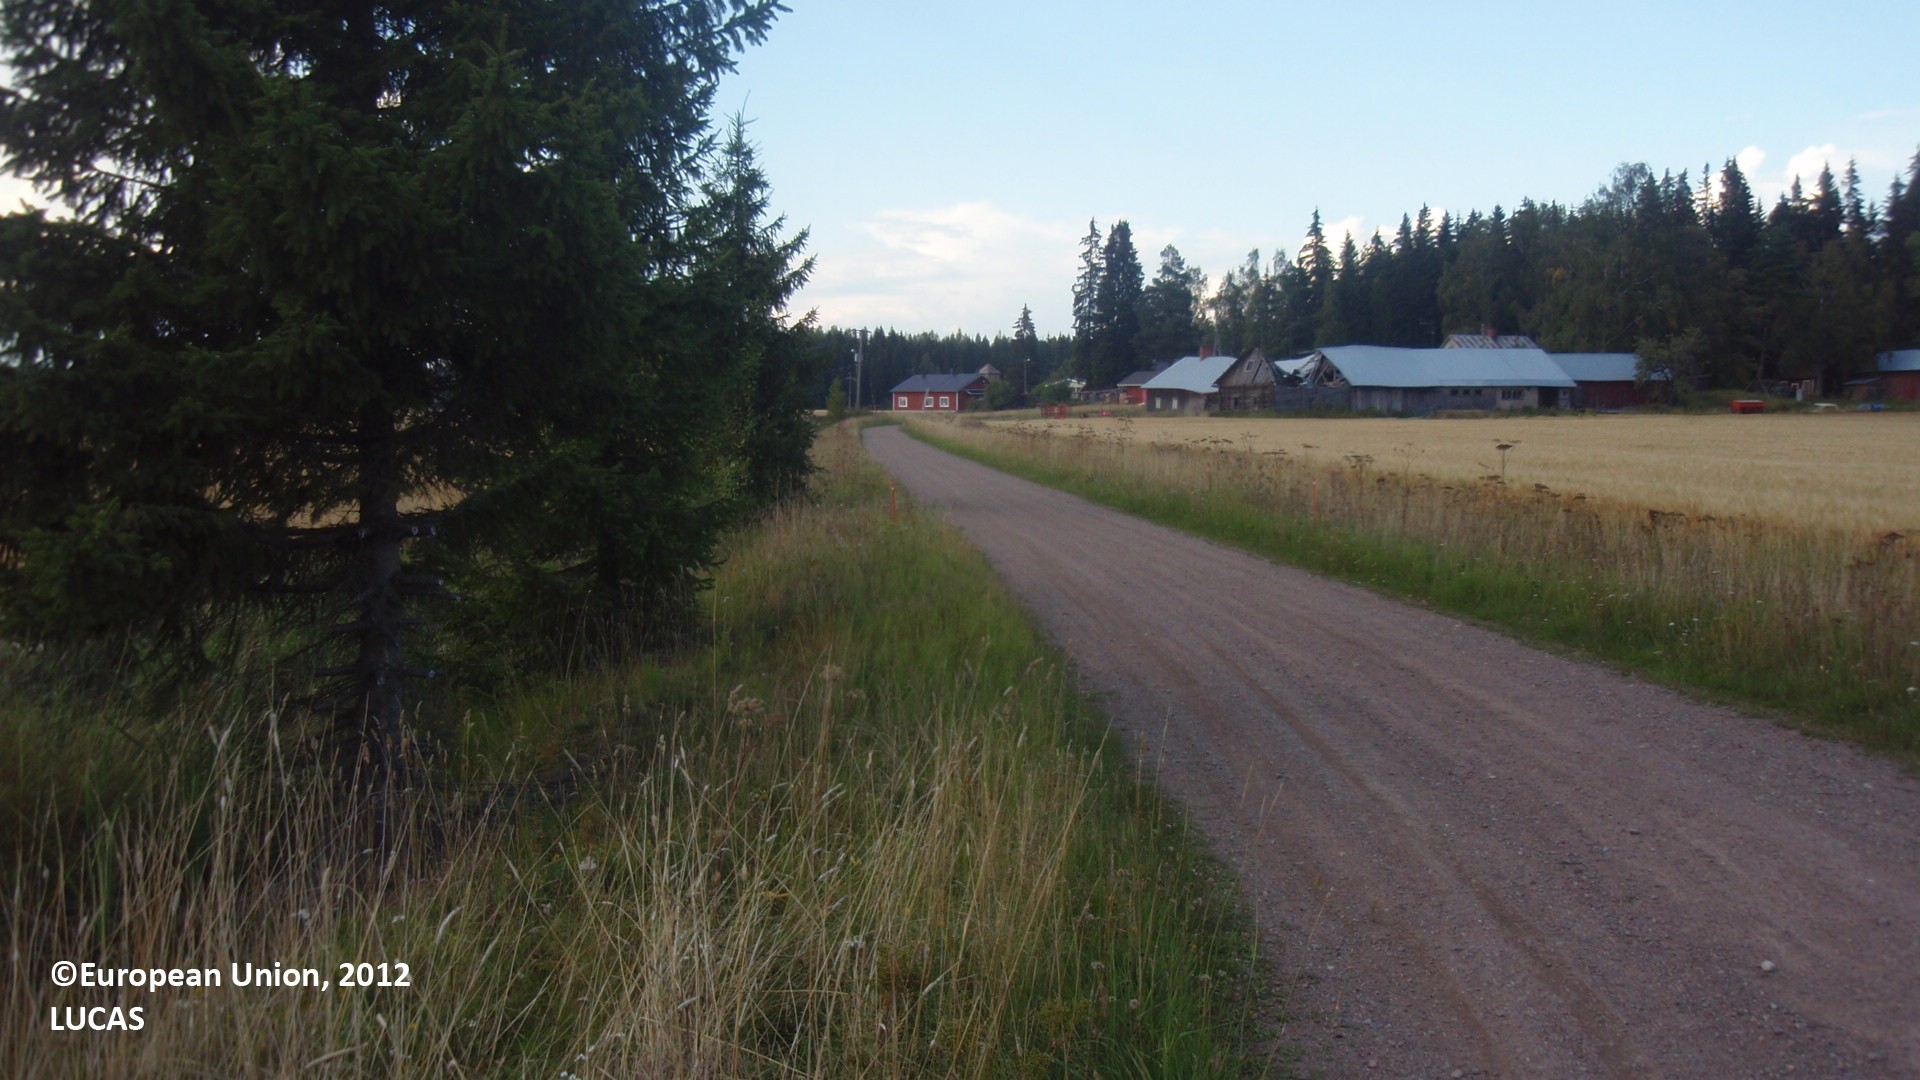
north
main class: Cropland
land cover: Oats
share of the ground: > 75 %
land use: Agriculture (excluding fallow land and kitchen gardens)
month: August
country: FI
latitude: 60.6975
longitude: 26.6250
